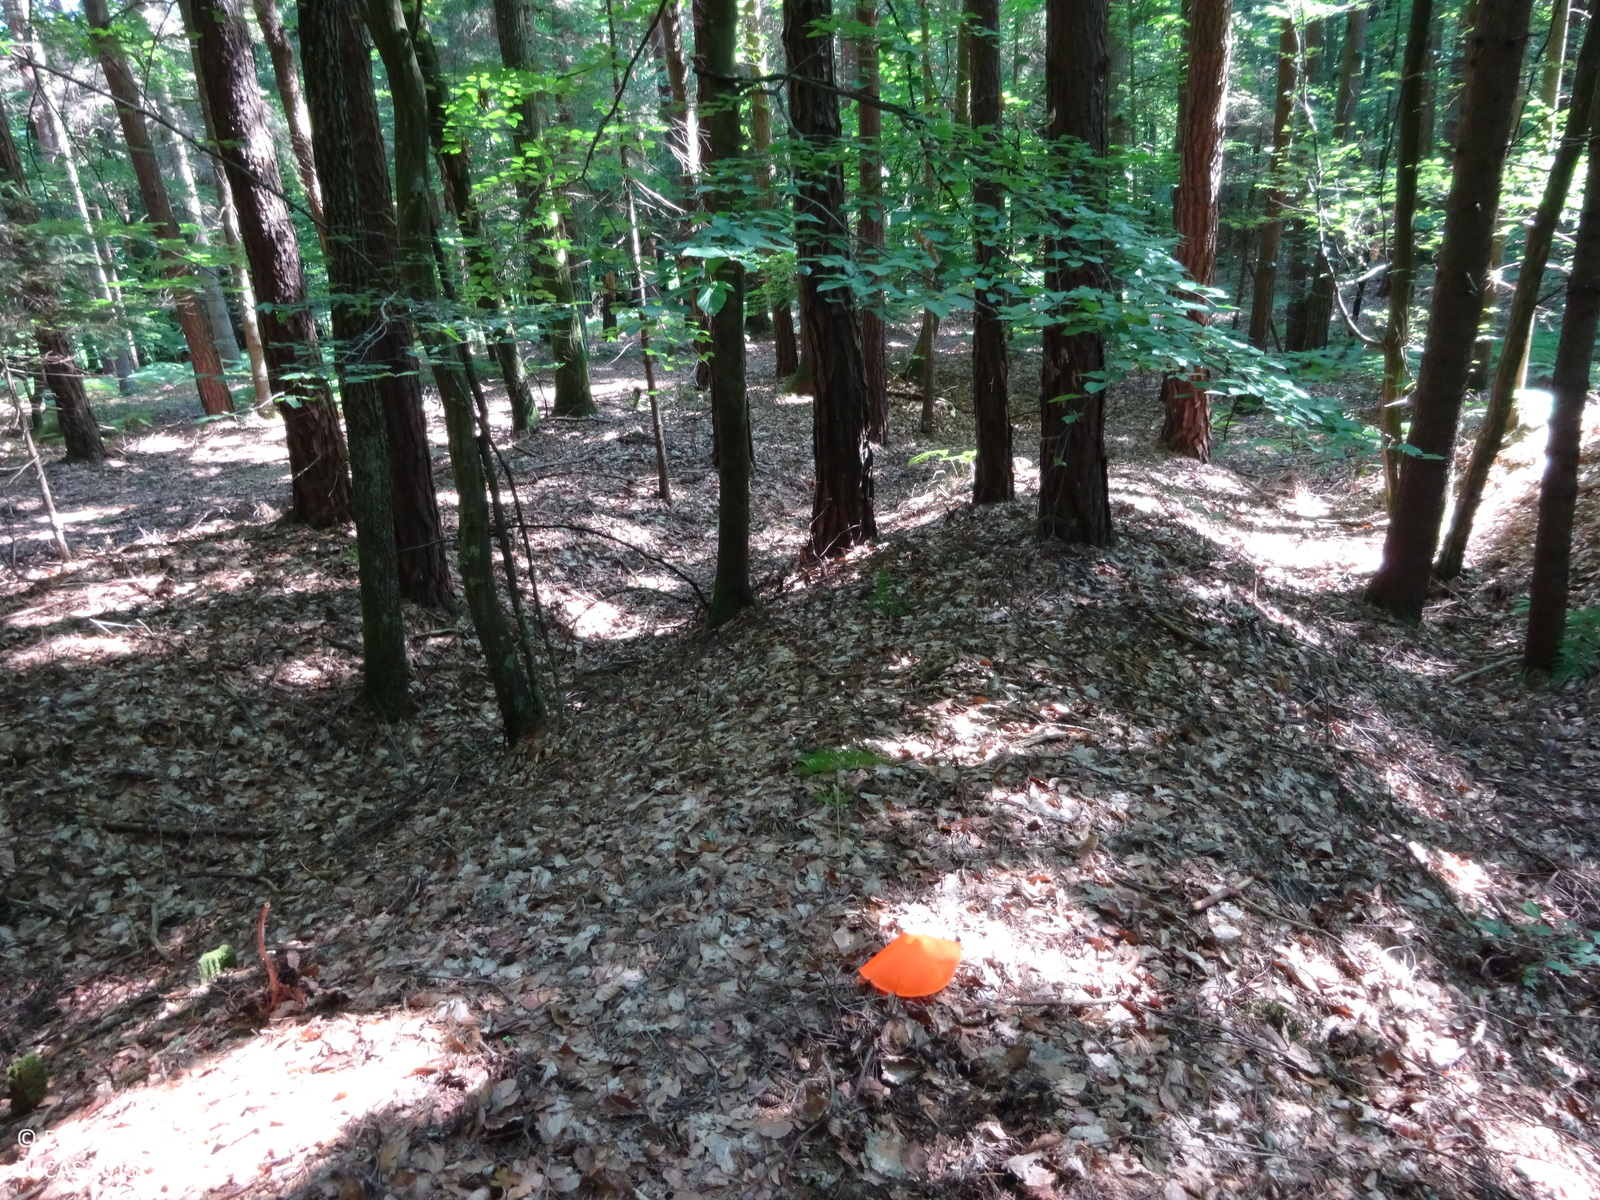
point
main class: Woodland
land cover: Pine dominated mixed woodland
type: hemiboreal forest and nemoral coniferous forest and mixed broadleaved-coniferous forest
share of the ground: > 75 %
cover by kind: broadleaved forest trees 65 %, coniferous forest trees 35 %
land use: Forestry
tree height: > 5 m
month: July
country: AT
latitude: 46.9171
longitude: 16.1070
